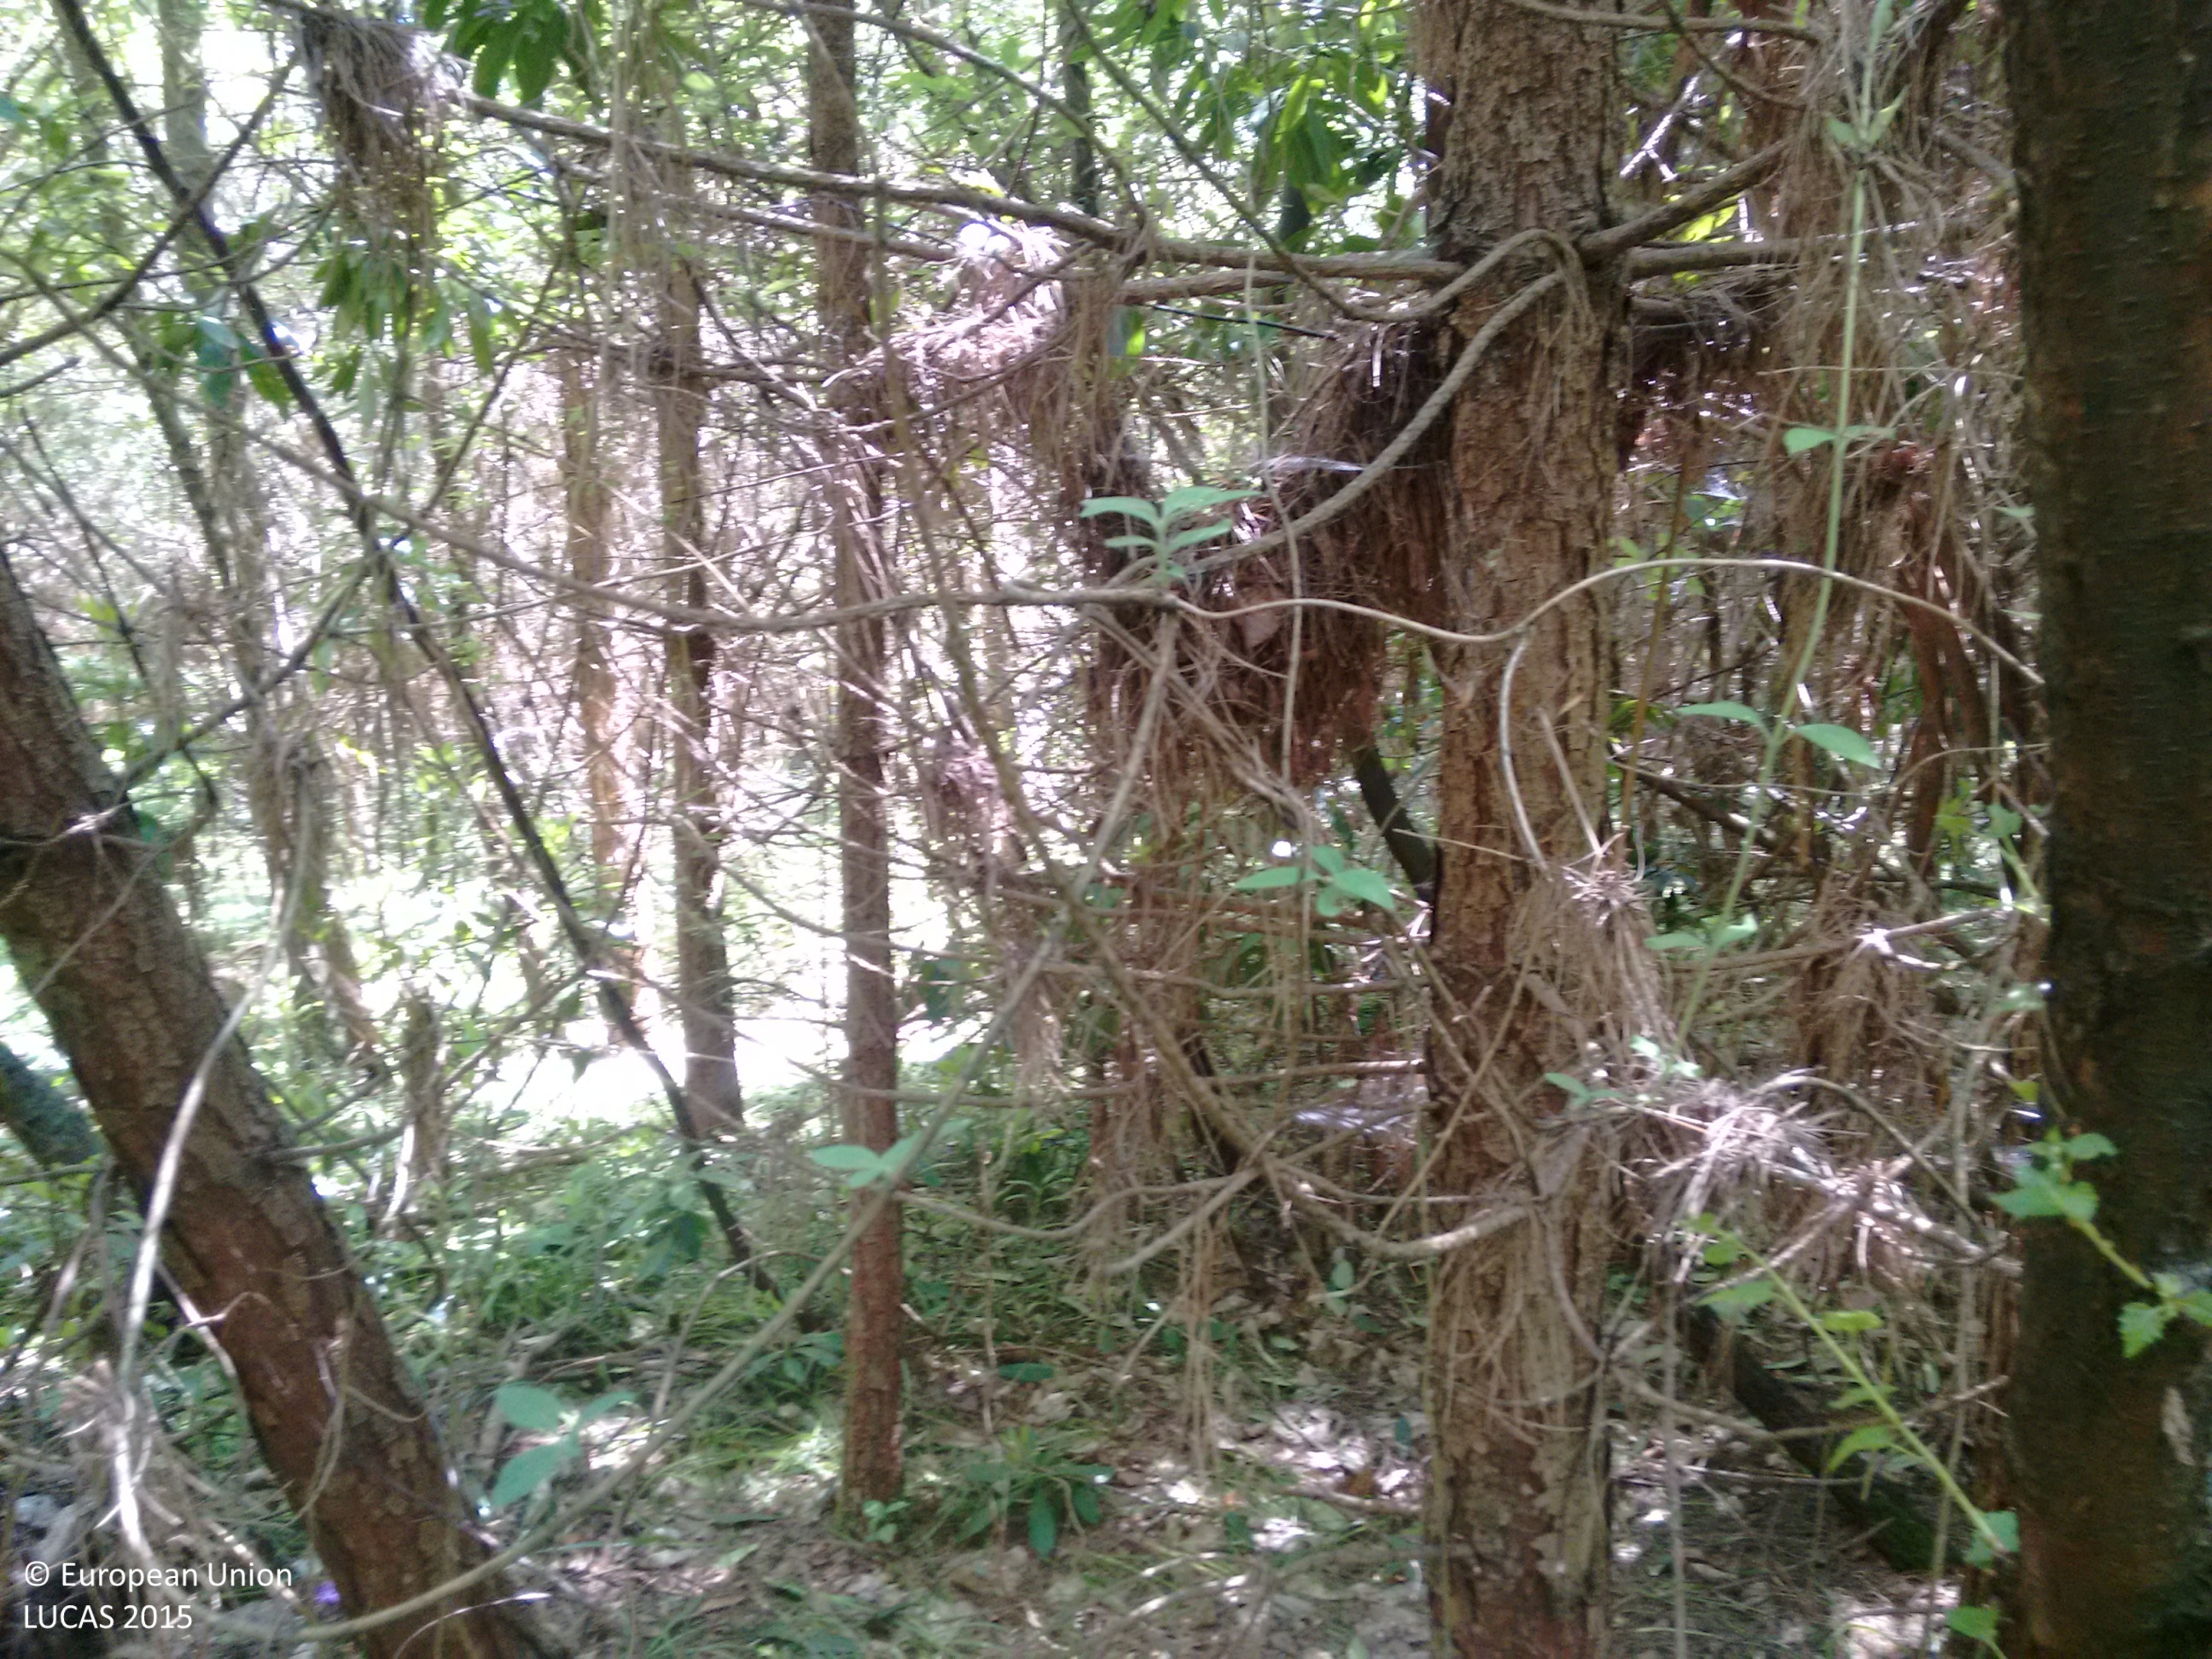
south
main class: Woodland
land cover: Other mixed woodland
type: exotic forest
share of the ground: > 75 %
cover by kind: coniferous forest trees 70 %, broadleaved forest trees 30 %
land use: Forestry
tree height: > 5 m
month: June
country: GB
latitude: 51.0708
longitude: 0.4814
